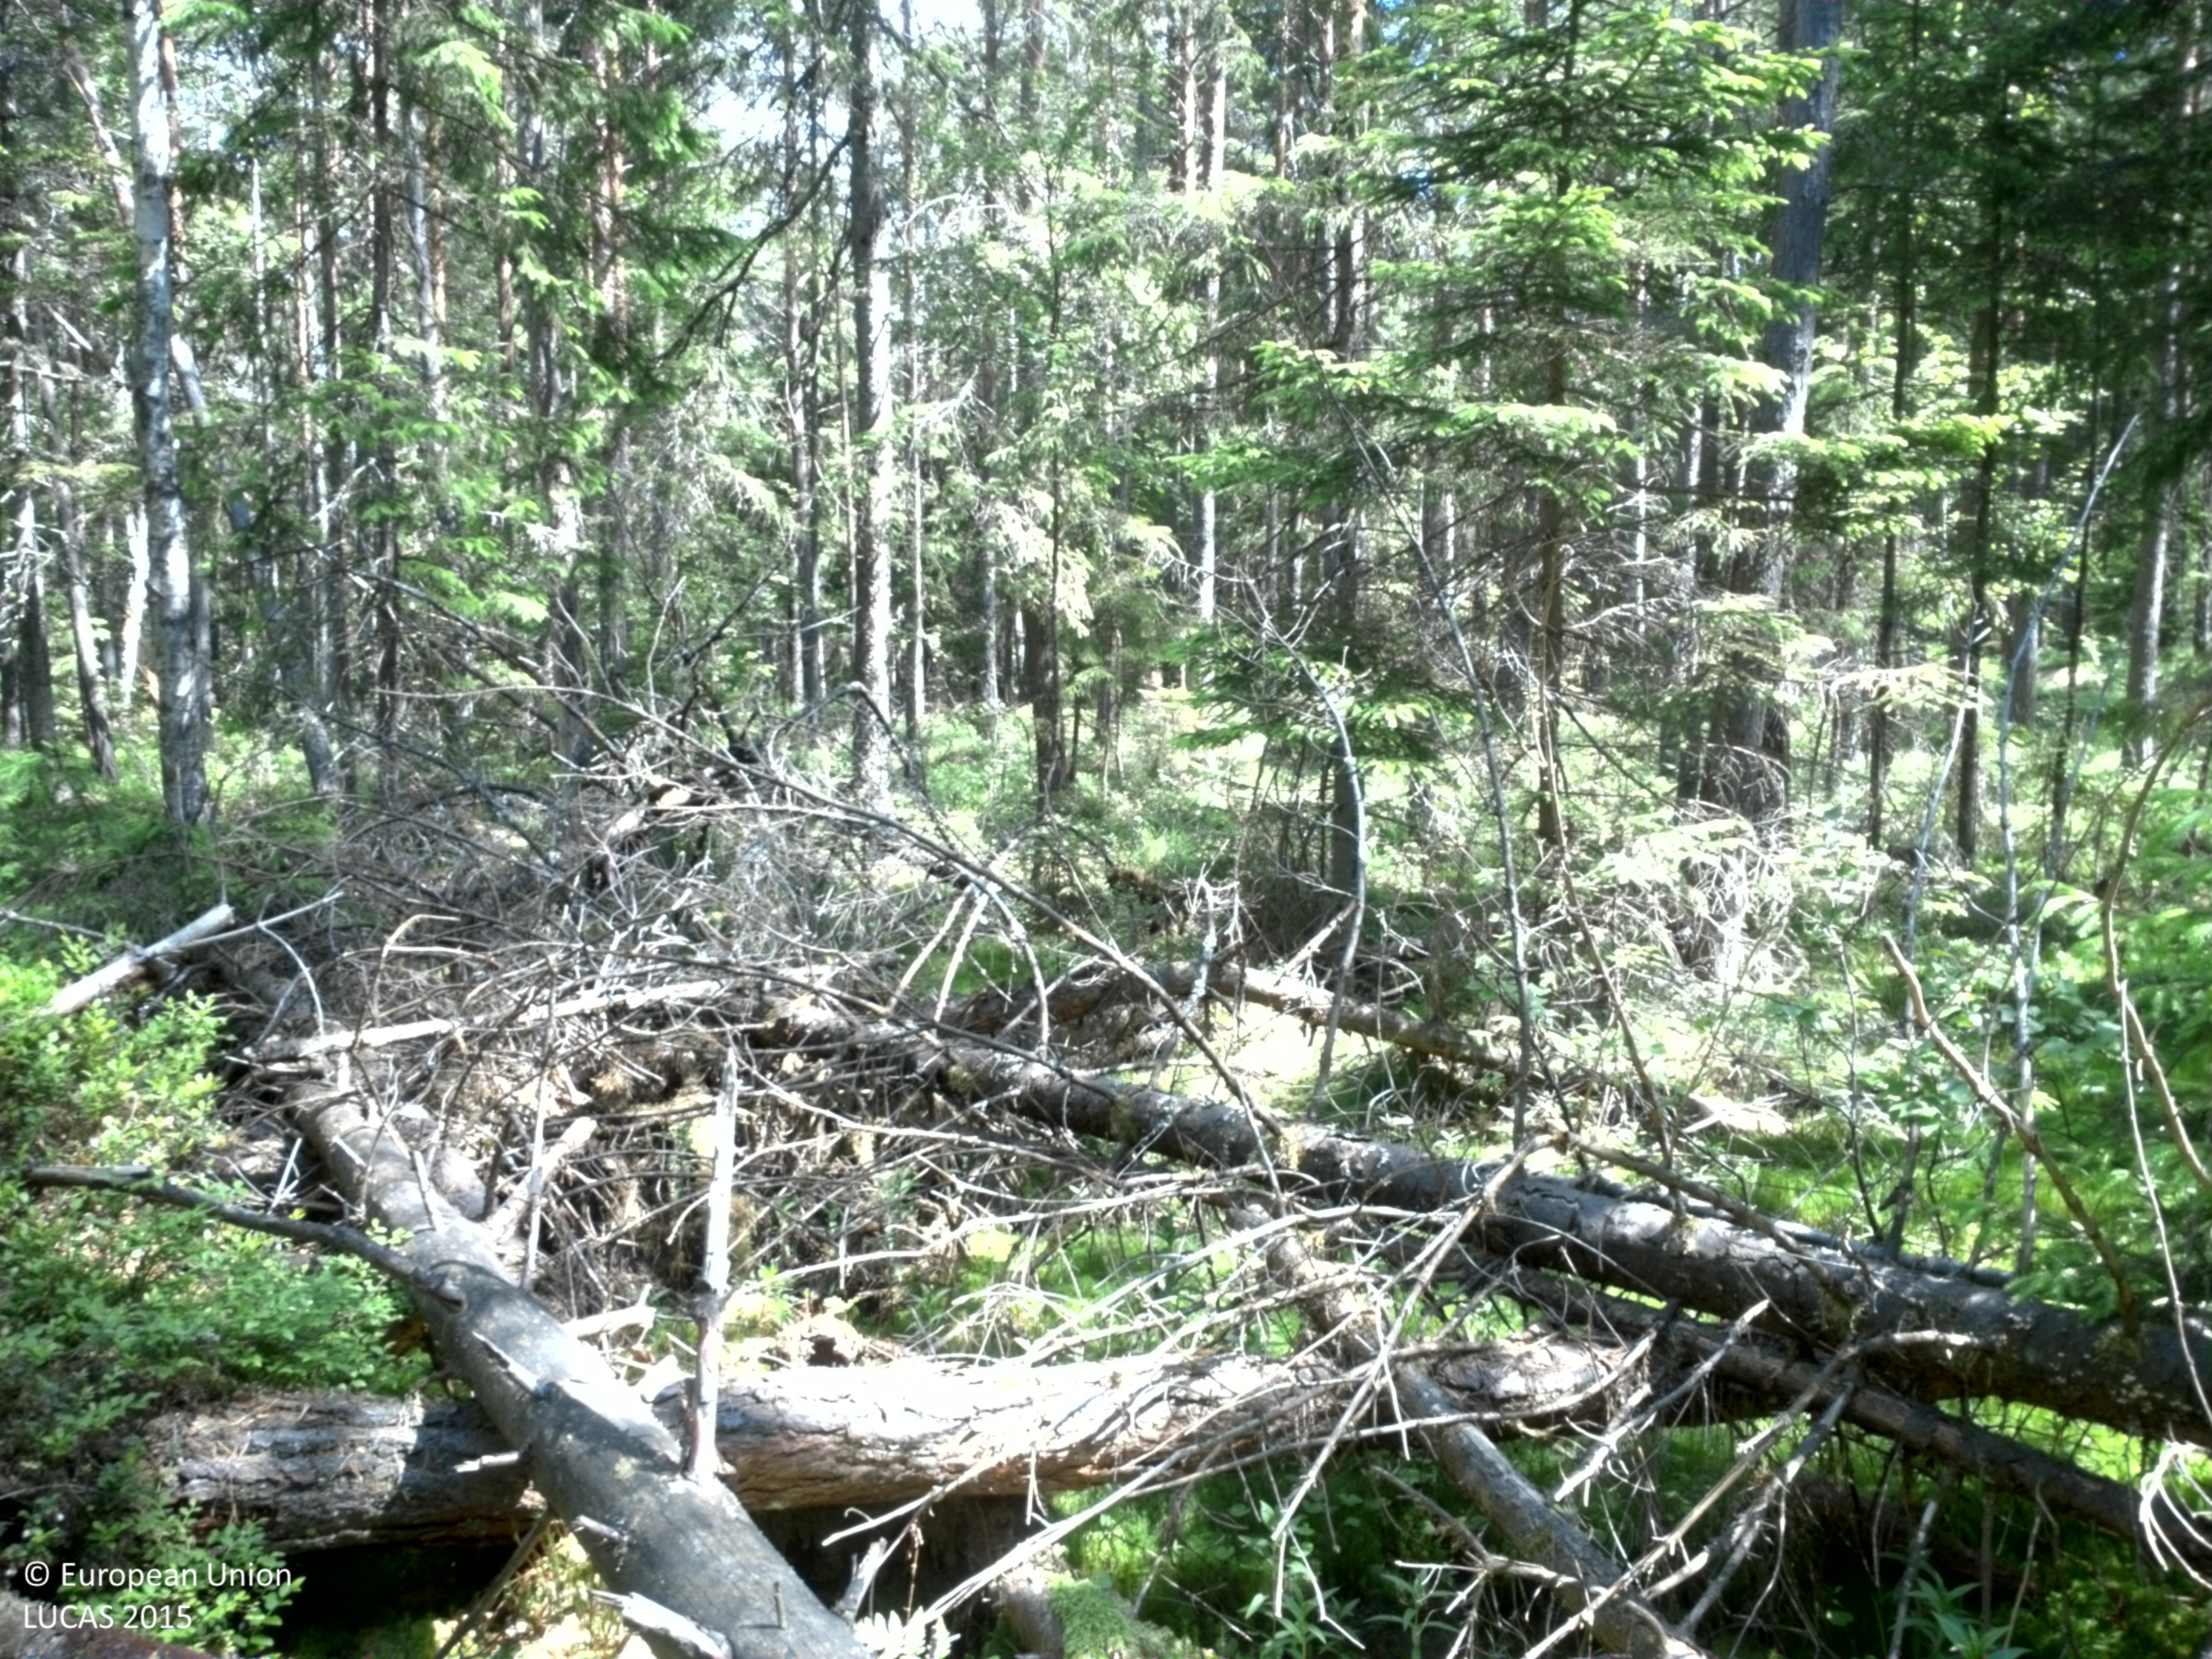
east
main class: Woodland
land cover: Pine dominated mixed woodland
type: boreal forest
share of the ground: 25 - 50 %
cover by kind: herbaceous plants 30 %, lichens and mosses 30 %, coniferous forest trees 25 %, broadleaved forest trees 15 %
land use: Forestry
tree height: > 5 m
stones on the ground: 25 - 50 %
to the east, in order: Pine dominated mixed woodland; Pine dominated coniferous woodland; Tracks; Pine dominated coniferous woodland
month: June
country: SE
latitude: 58.5822
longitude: 15.3428
